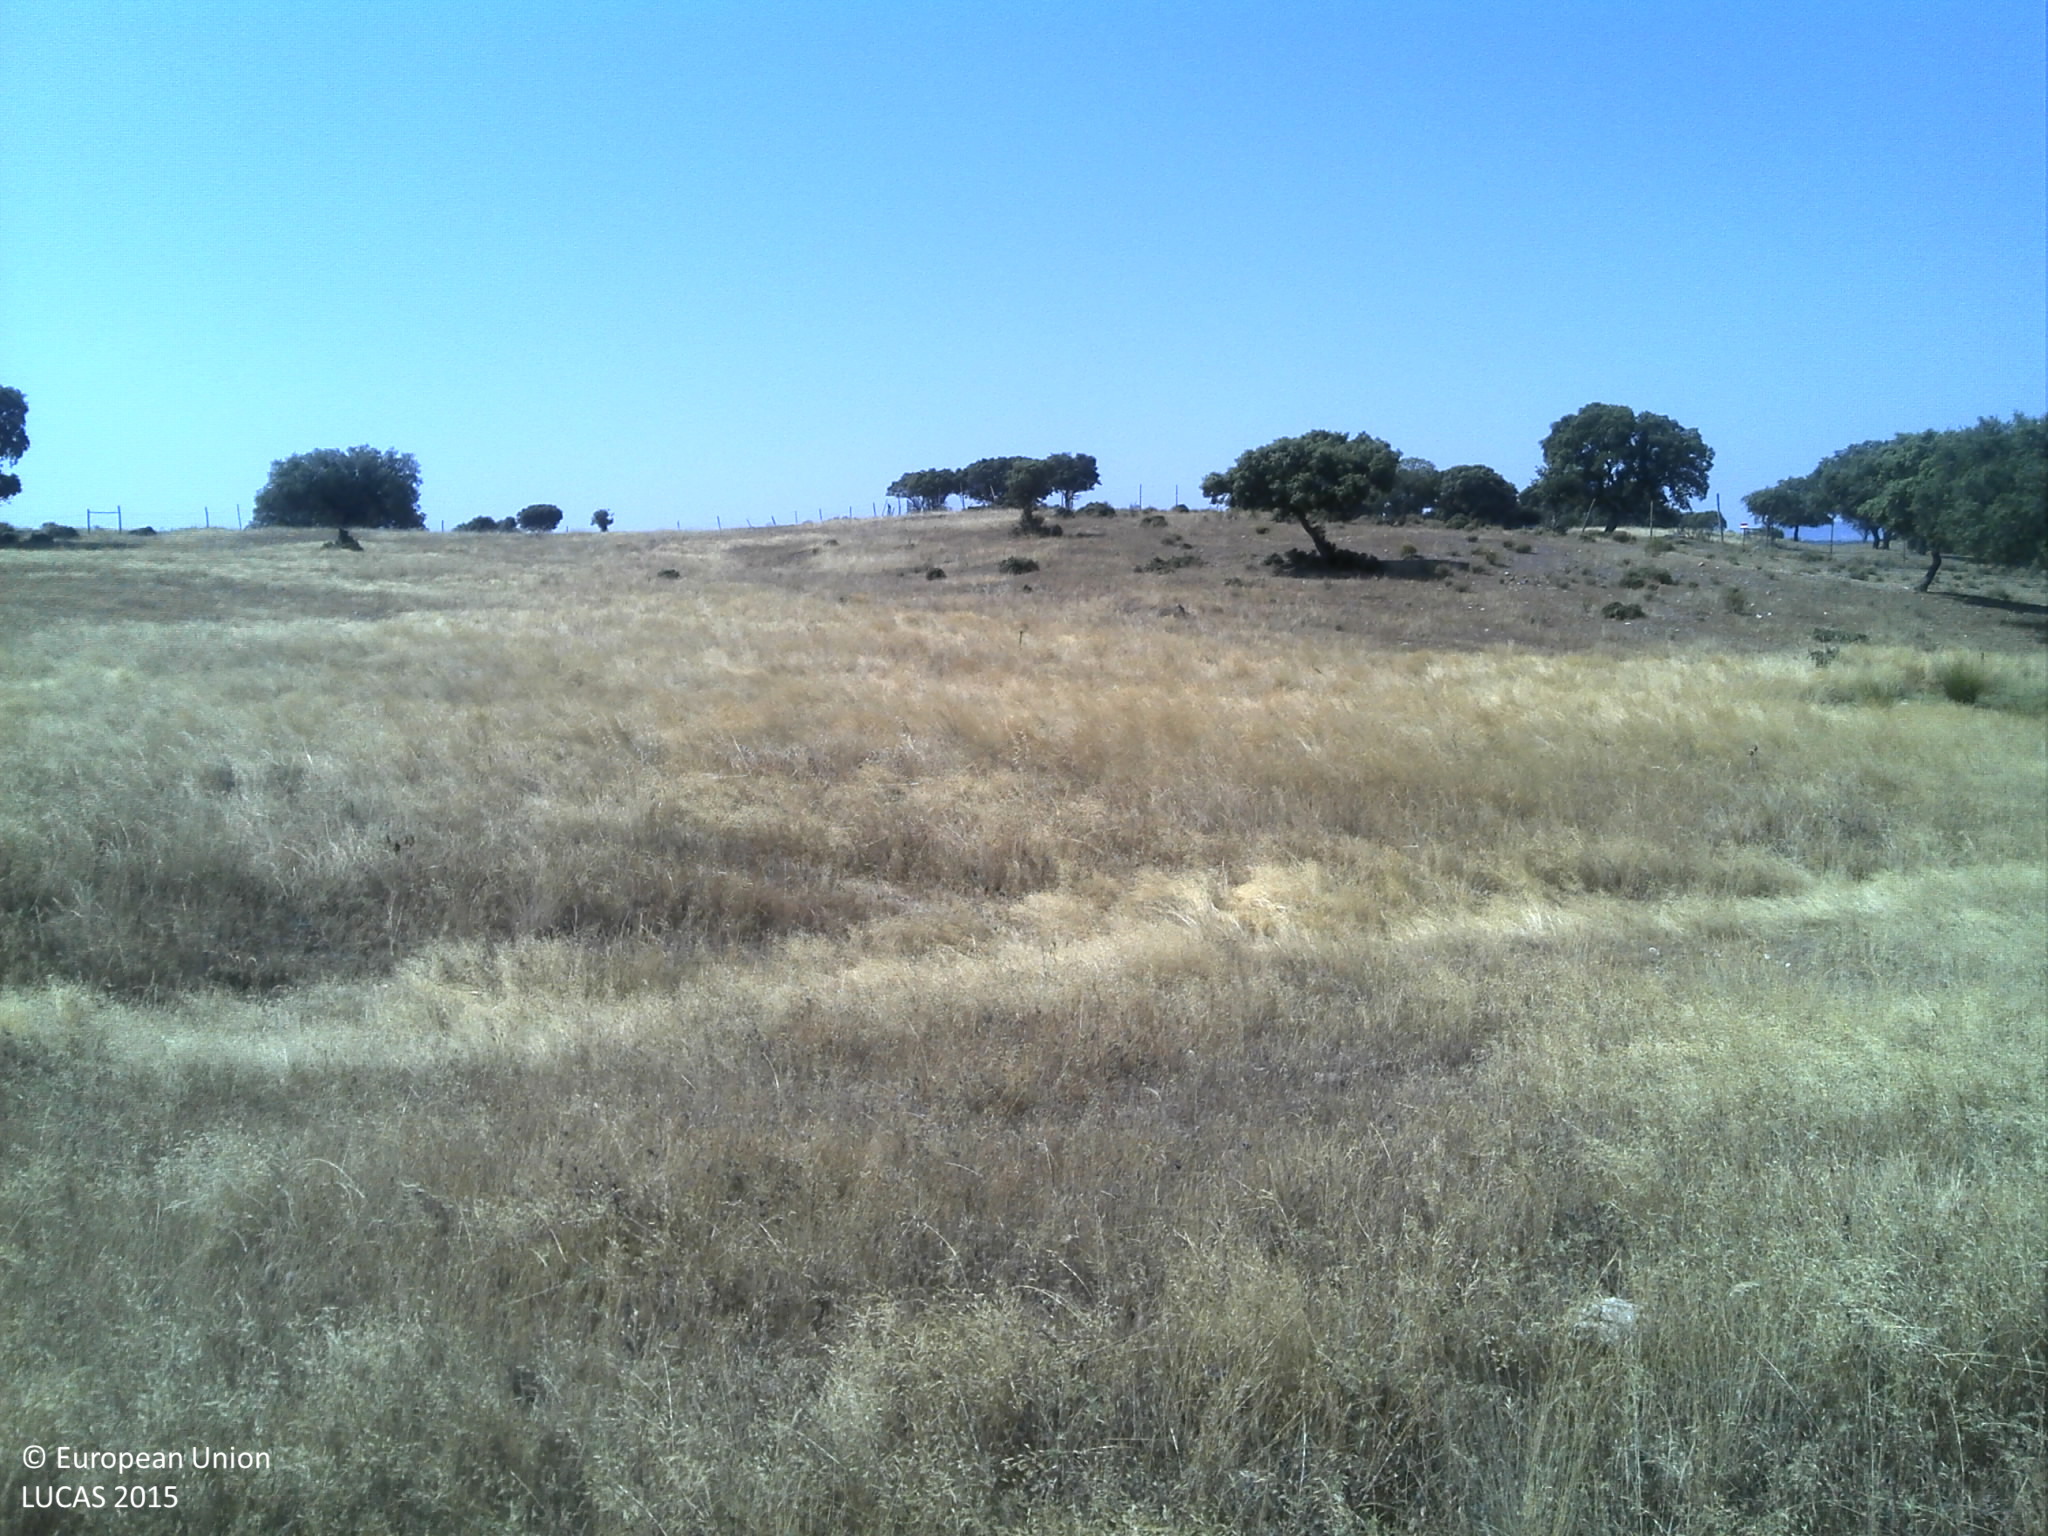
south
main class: Grassland
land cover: Grassland without tree/shrub cover
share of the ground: > 75 %
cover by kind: herbaceous plants 80 %, unconsolidated bare surface 10 %, shrubs 5 %
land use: Agriculture (excluding fallow land and kitchen gardens)
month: June
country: PT
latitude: 39.6803
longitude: -7.0739
